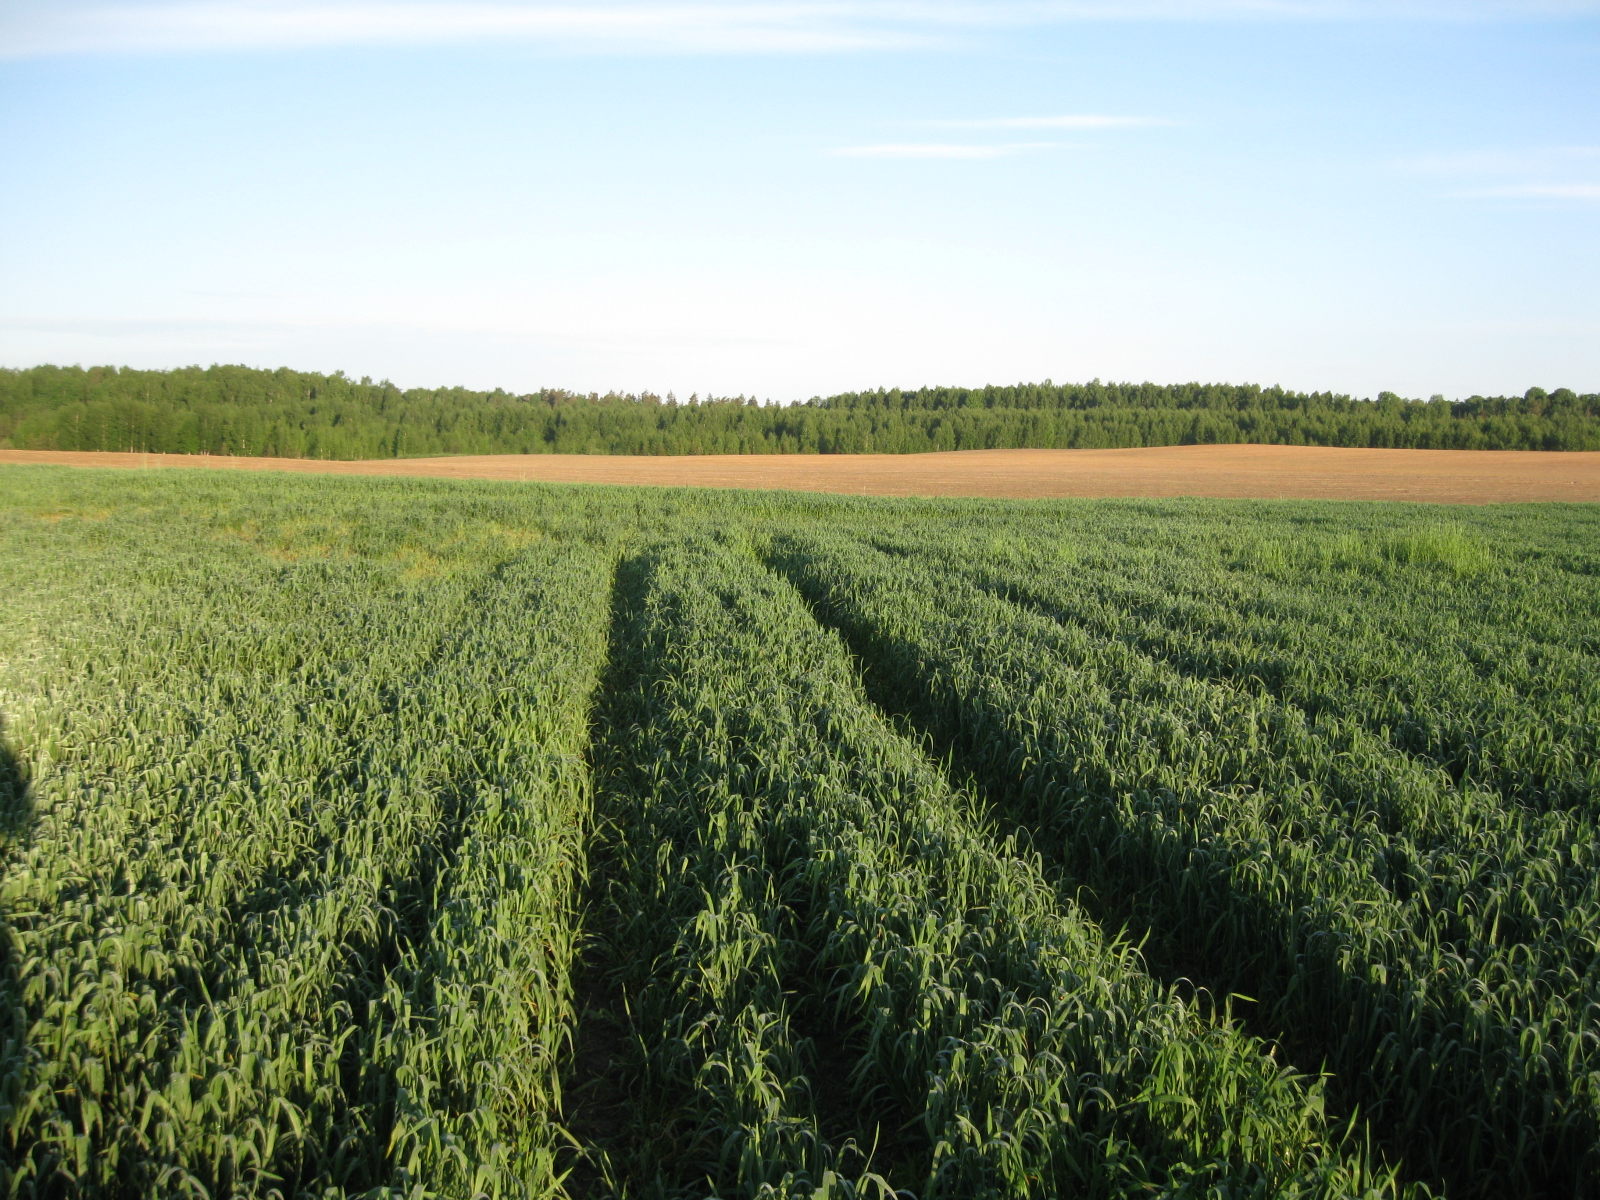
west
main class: Cropland
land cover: Common wheat
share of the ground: > 75 %
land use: Agriculture (excluding fallow land and kitchen gardens)
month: May
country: LT
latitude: 55.6589
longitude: 24.7443
